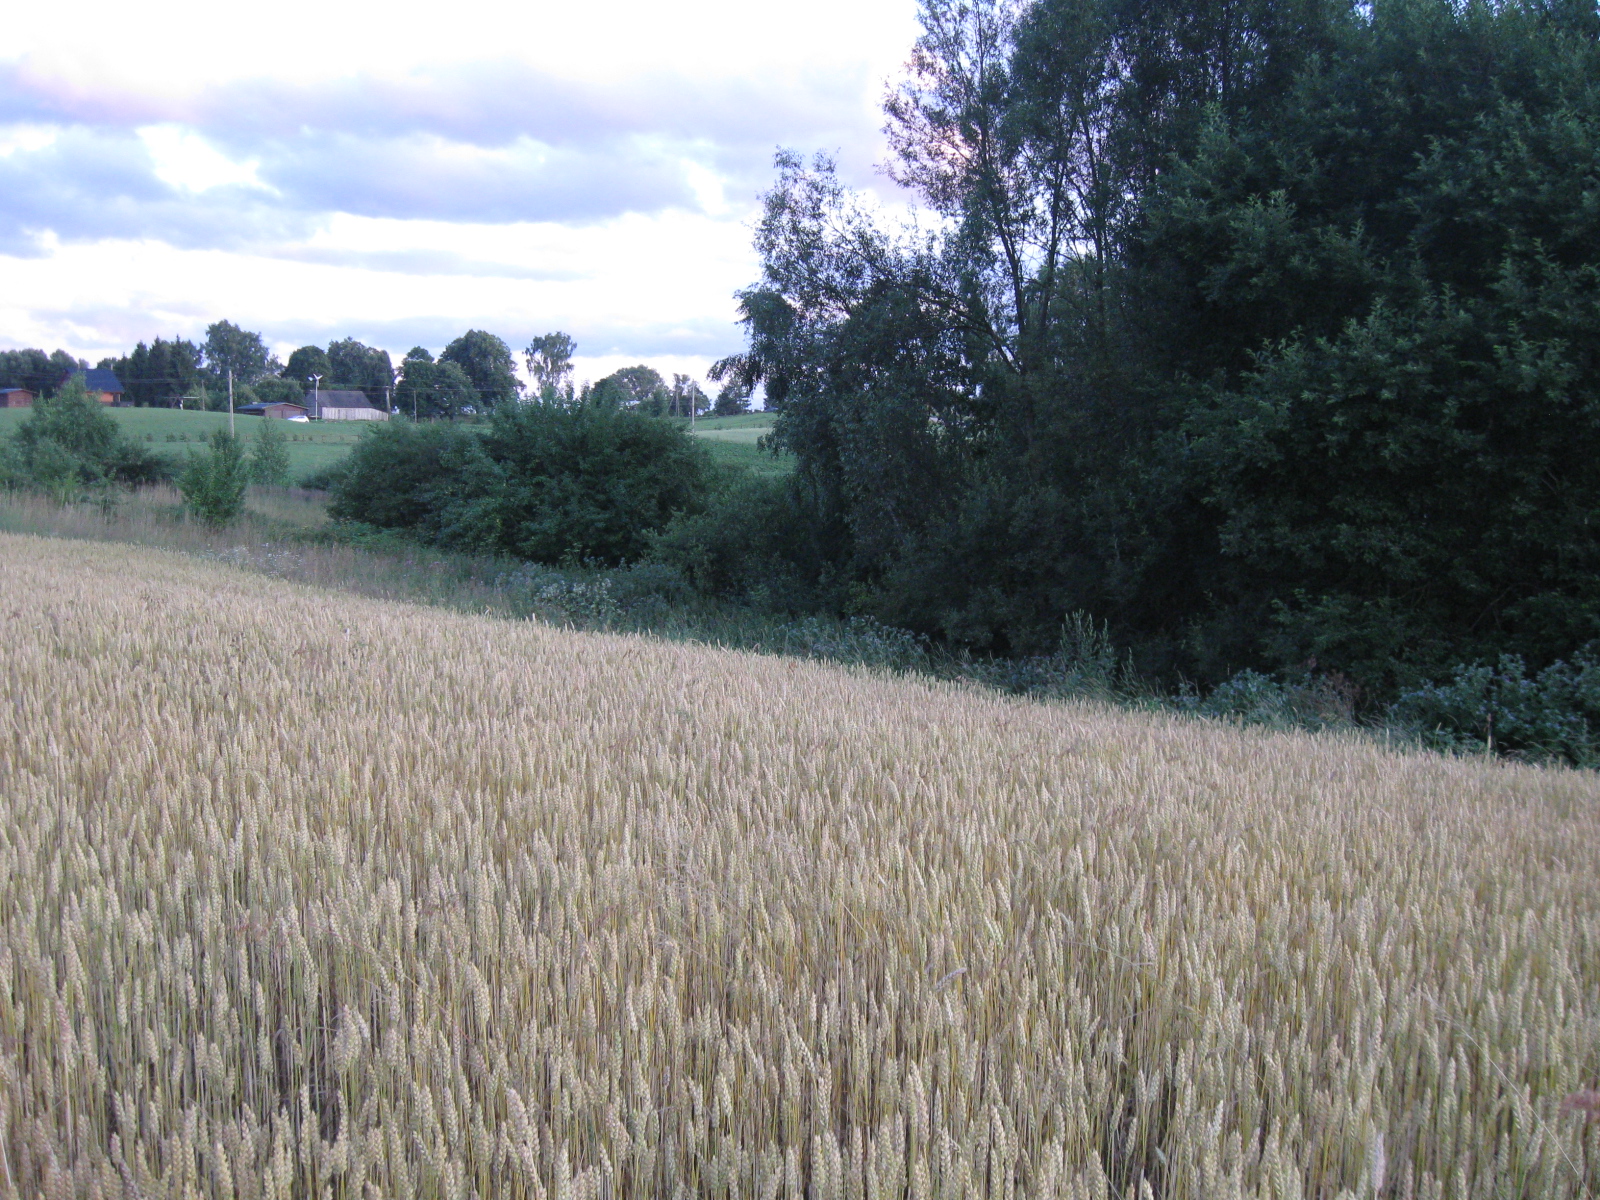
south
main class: Cropland
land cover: Common wheat
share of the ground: > 75 %
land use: Agriculture (excluding fallow land and kitchen gardens)
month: July
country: LT
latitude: 54.3707
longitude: 24.3380
